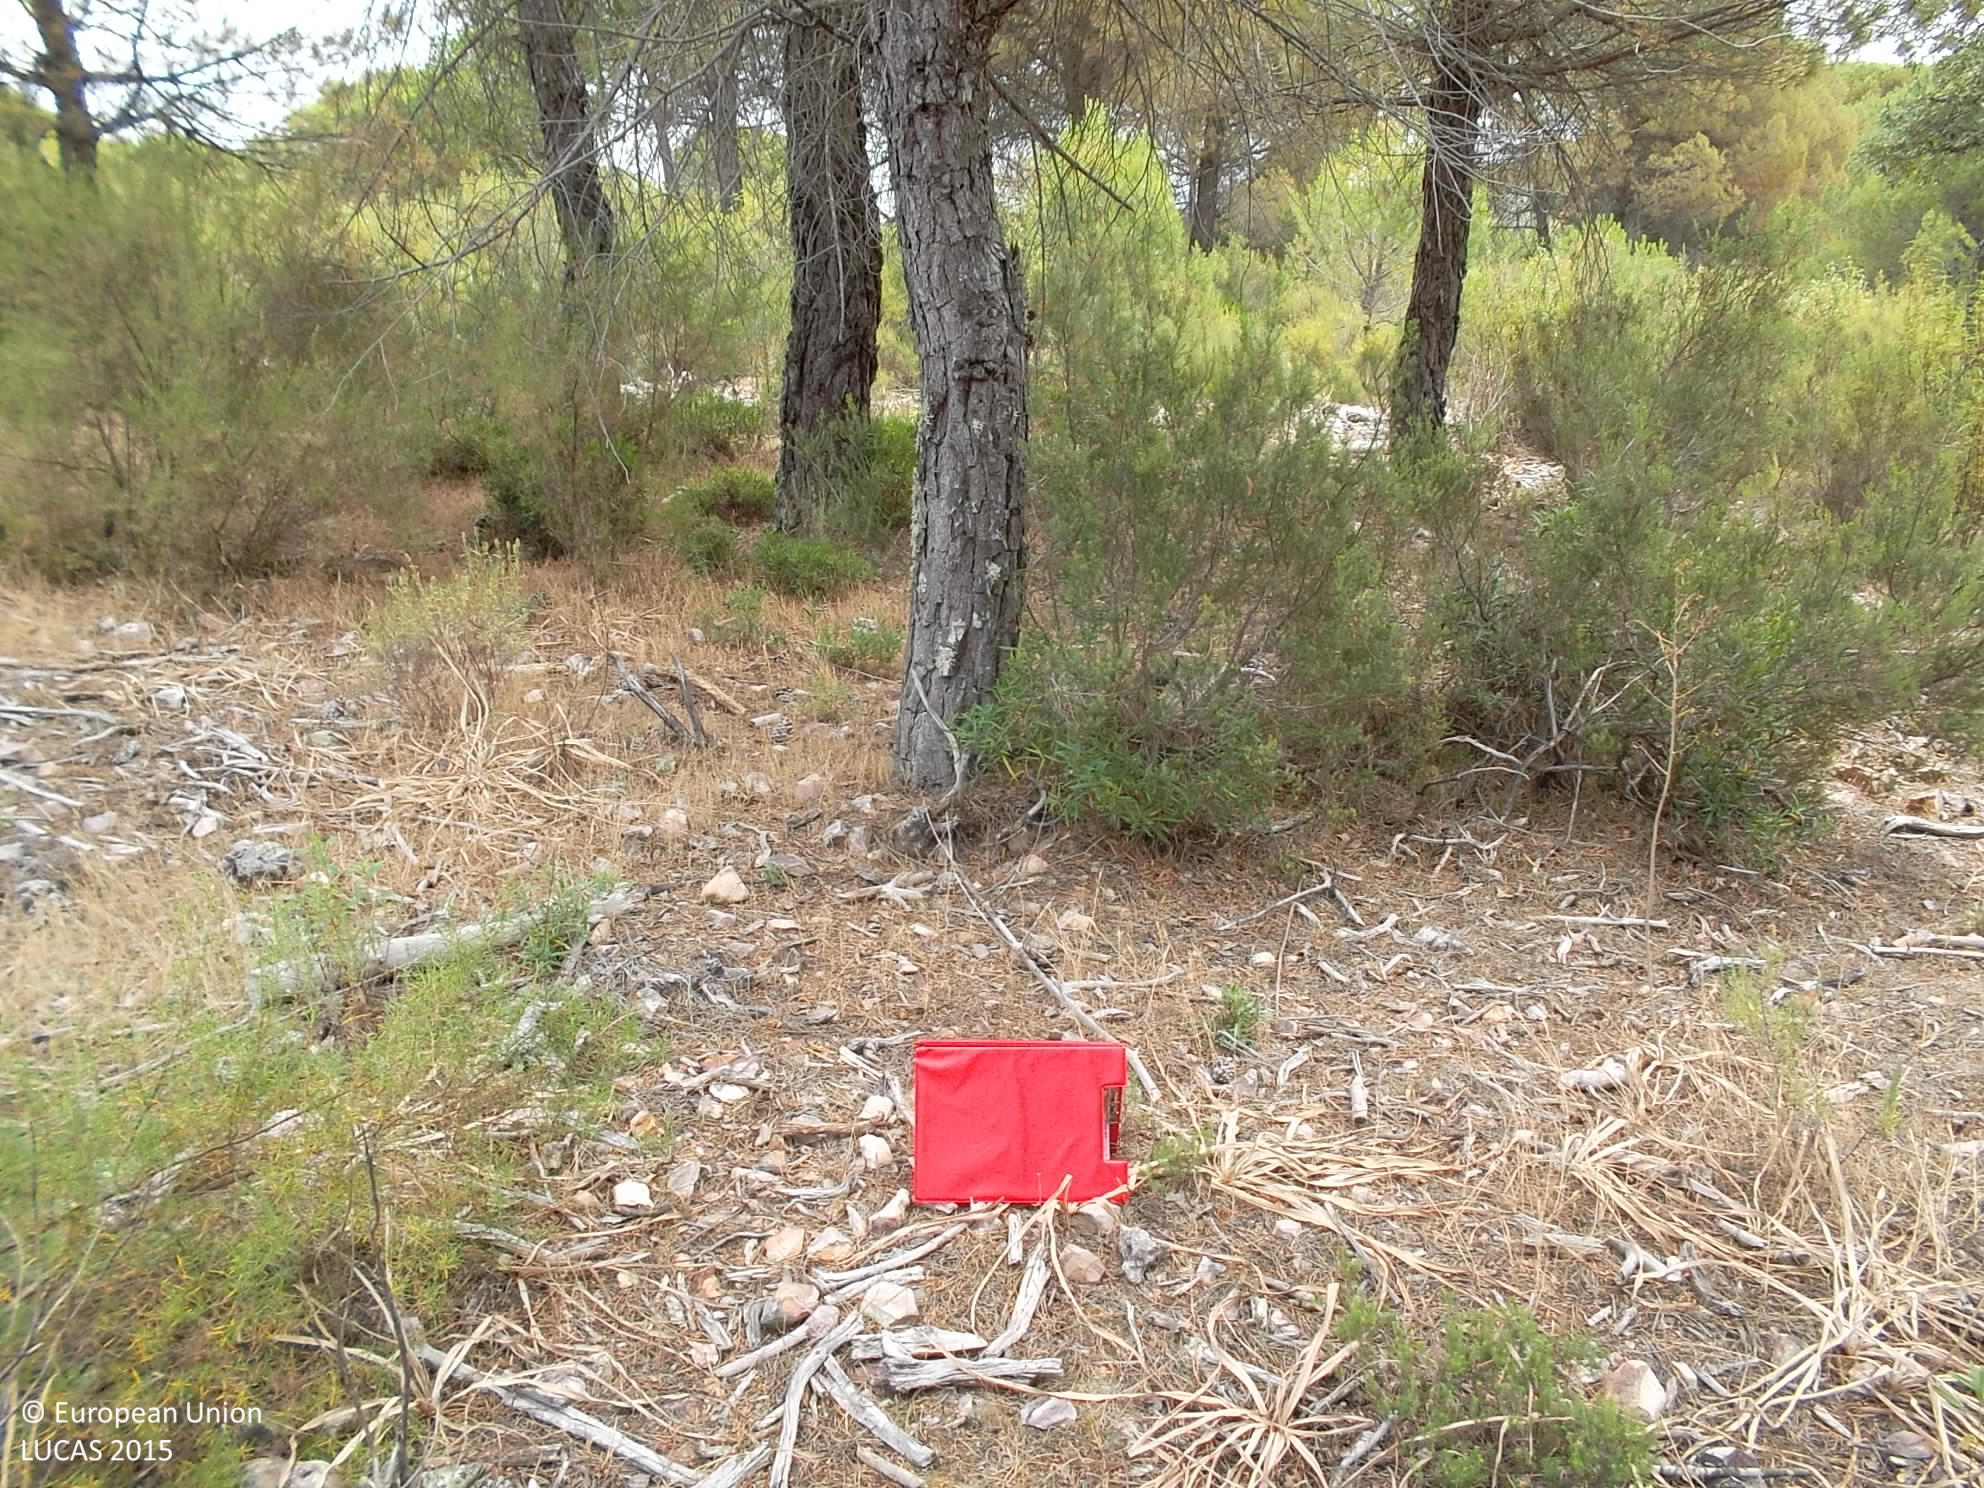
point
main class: Woodland
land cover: Pine dominated coniferous woodland
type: coniferous forest of the mediterranean region
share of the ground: > 75 %
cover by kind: coniferous forest trees 60 %, shrubs 30 %, herbaceous plants 10 %
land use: Forestry
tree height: > 5 m
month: June
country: ES
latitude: 39.2998
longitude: -4.9400
